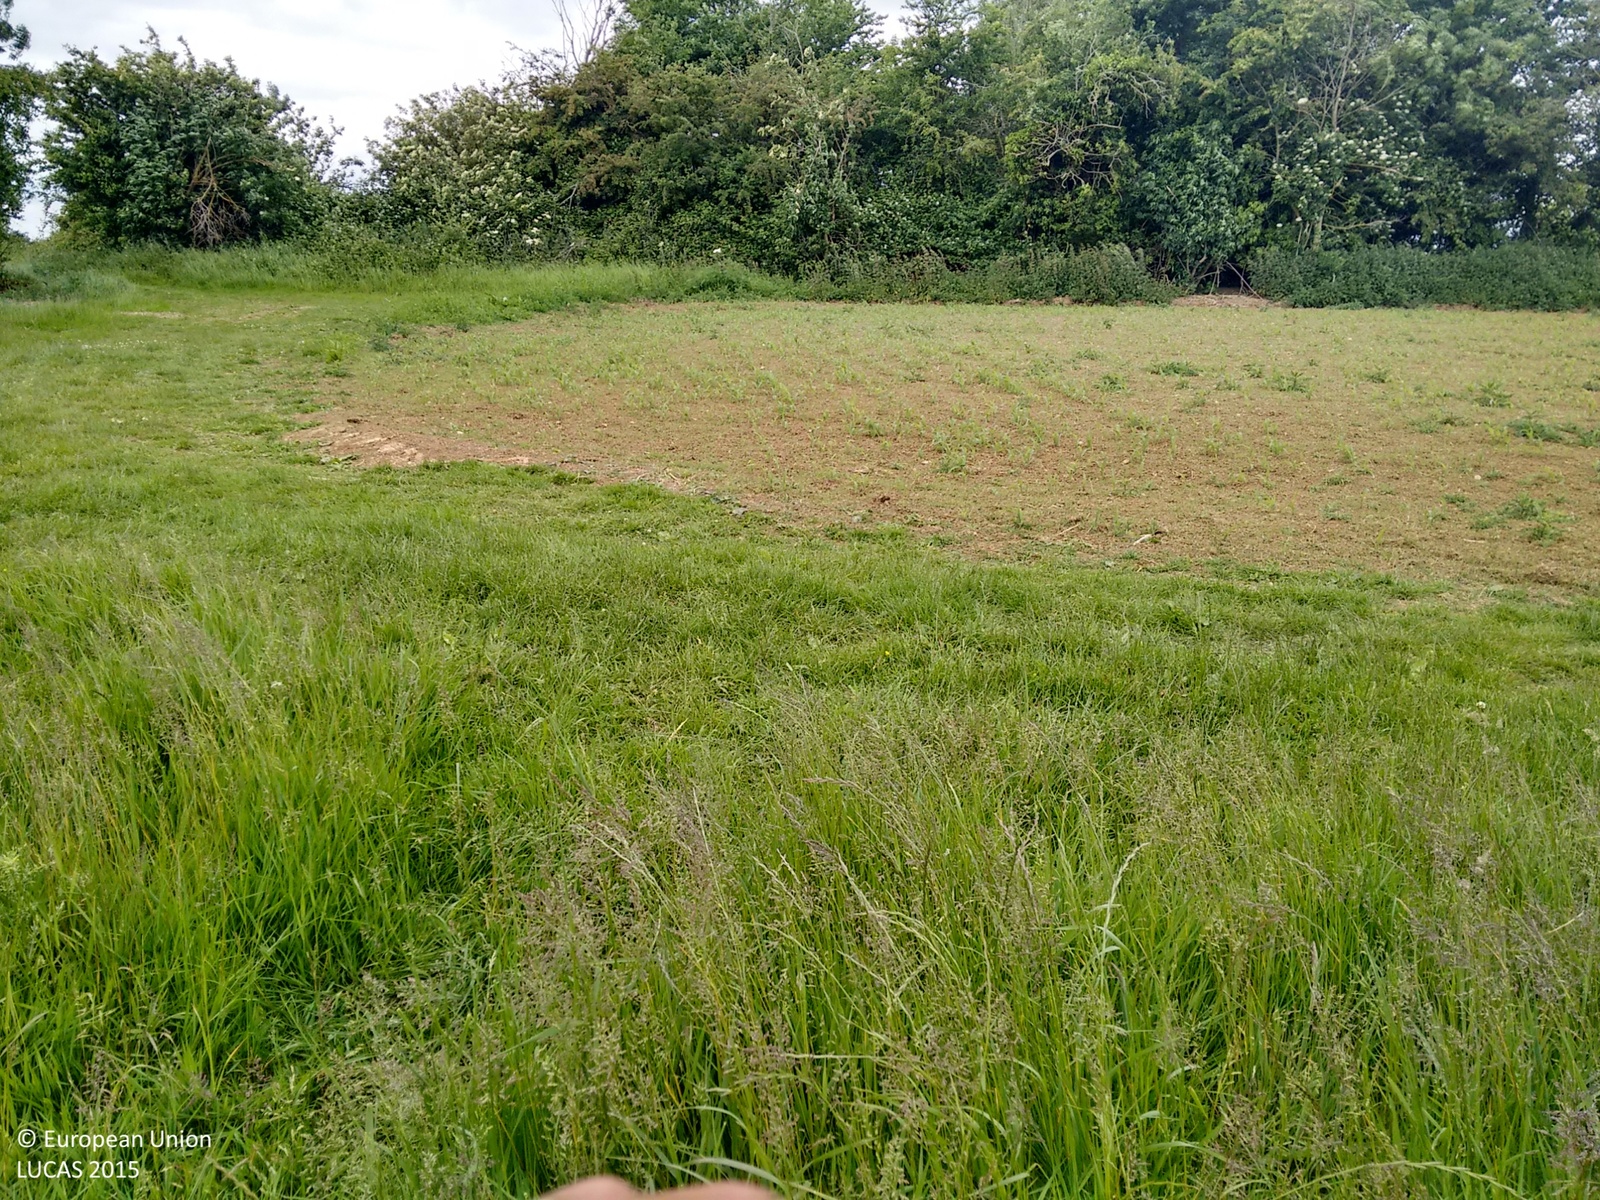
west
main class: Cropland
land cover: Common wheat
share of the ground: > 75 %
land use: Agriculture (excluding fallow land and kitchen gardens)
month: June
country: GB
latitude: 52.1036
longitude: -1.7193
